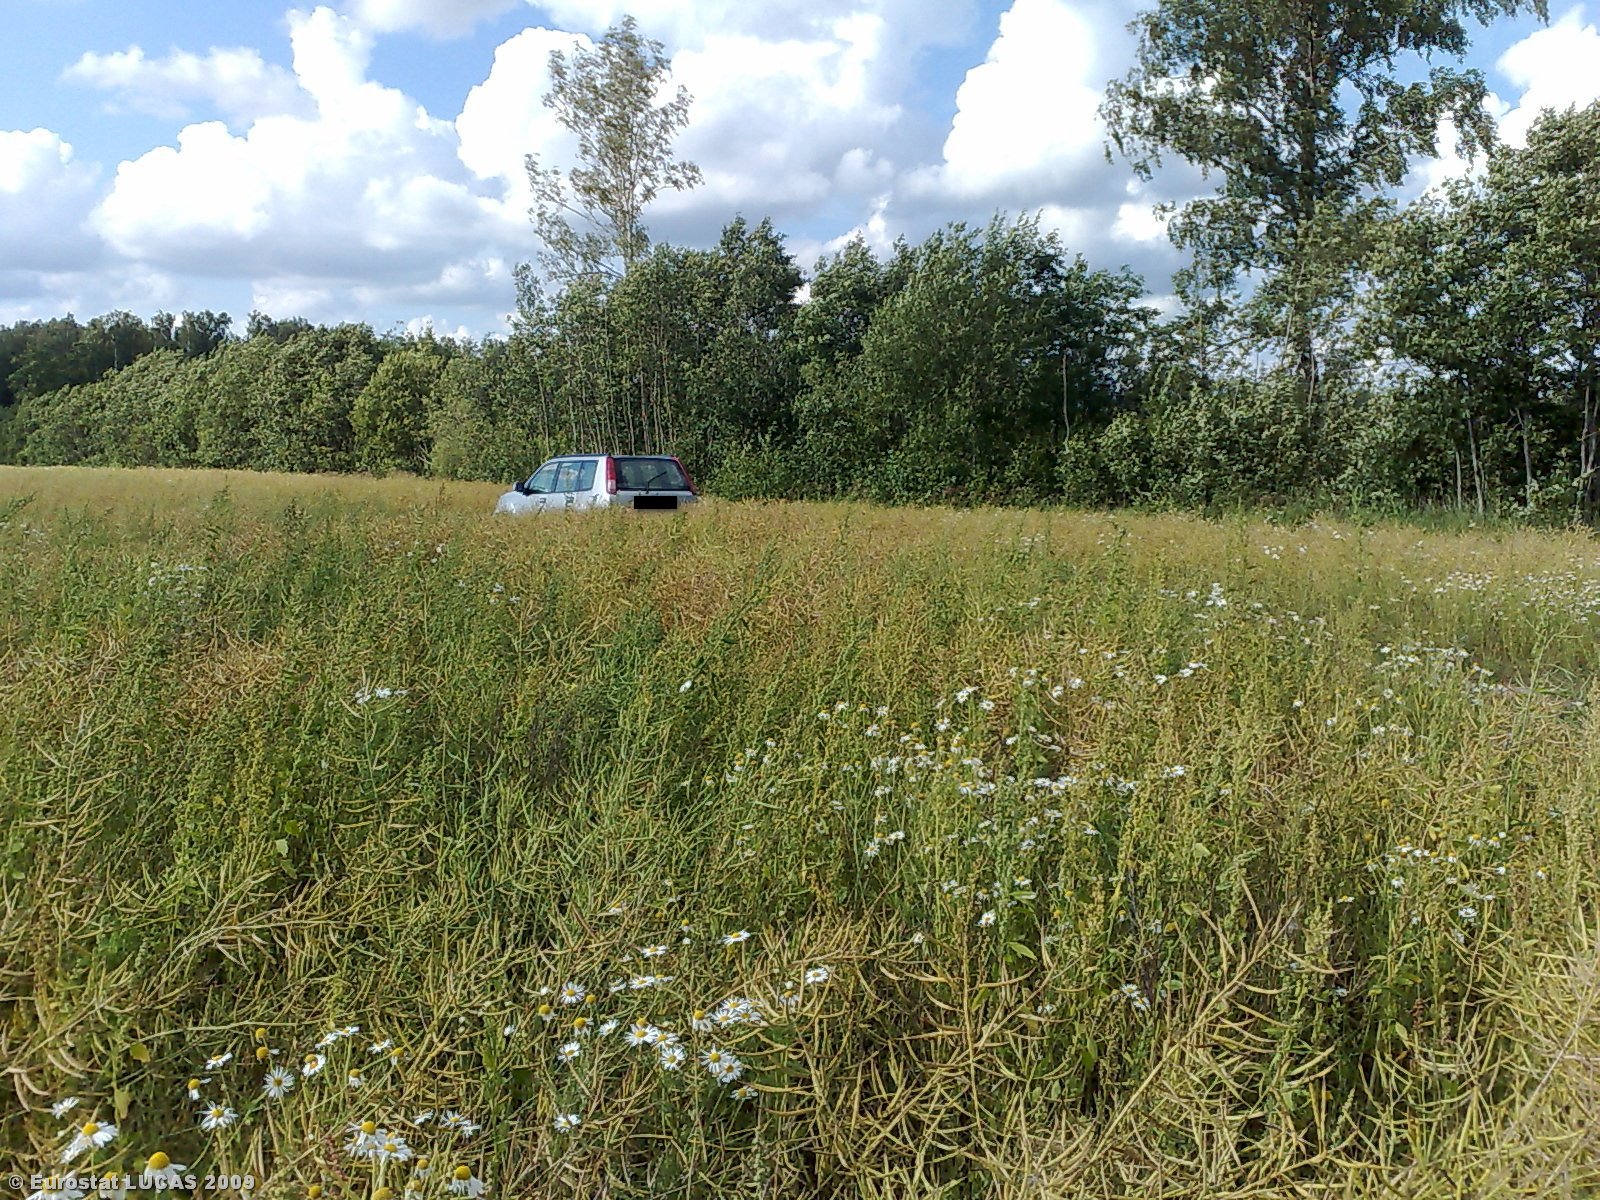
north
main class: Cropland
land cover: Rape and turnip rape
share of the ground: > 75 %
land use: Agriculture (excluding fallow land and kitchen gardens)
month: July
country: LT
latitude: 56.0829
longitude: 22.8724
